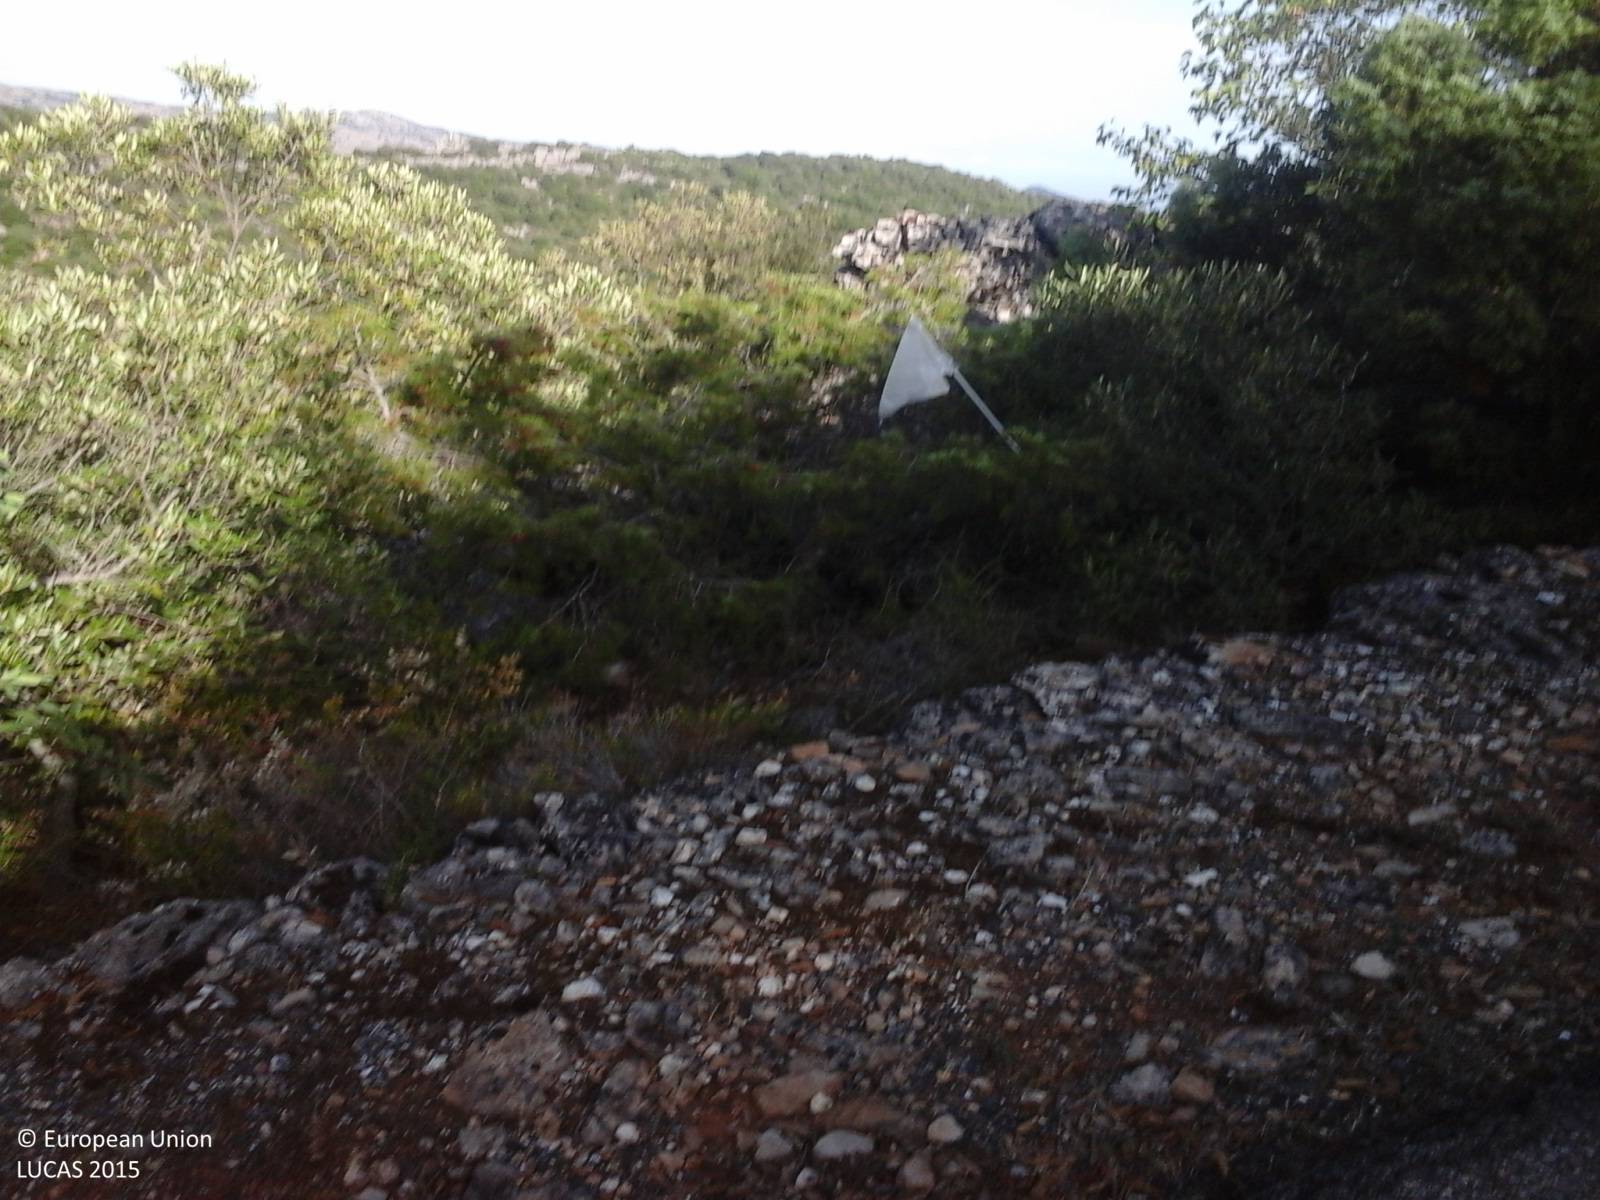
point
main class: Woodland
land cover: Pine dominated mixed woodland
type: coniferous forest of the mediterranean region
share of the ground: > 75 %
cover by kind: coniferous forest trees 50 %, broadleaved forest trees 25 %, shrubs 10 %, herbaceous plants 5 %, consolidated bare surface 5 %, unconsolidated bare surface 5 %
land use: Semi-natural and natural areas not in use
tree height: > 5 m
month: September
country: IT
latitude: 39.8314
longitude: 9.4772
